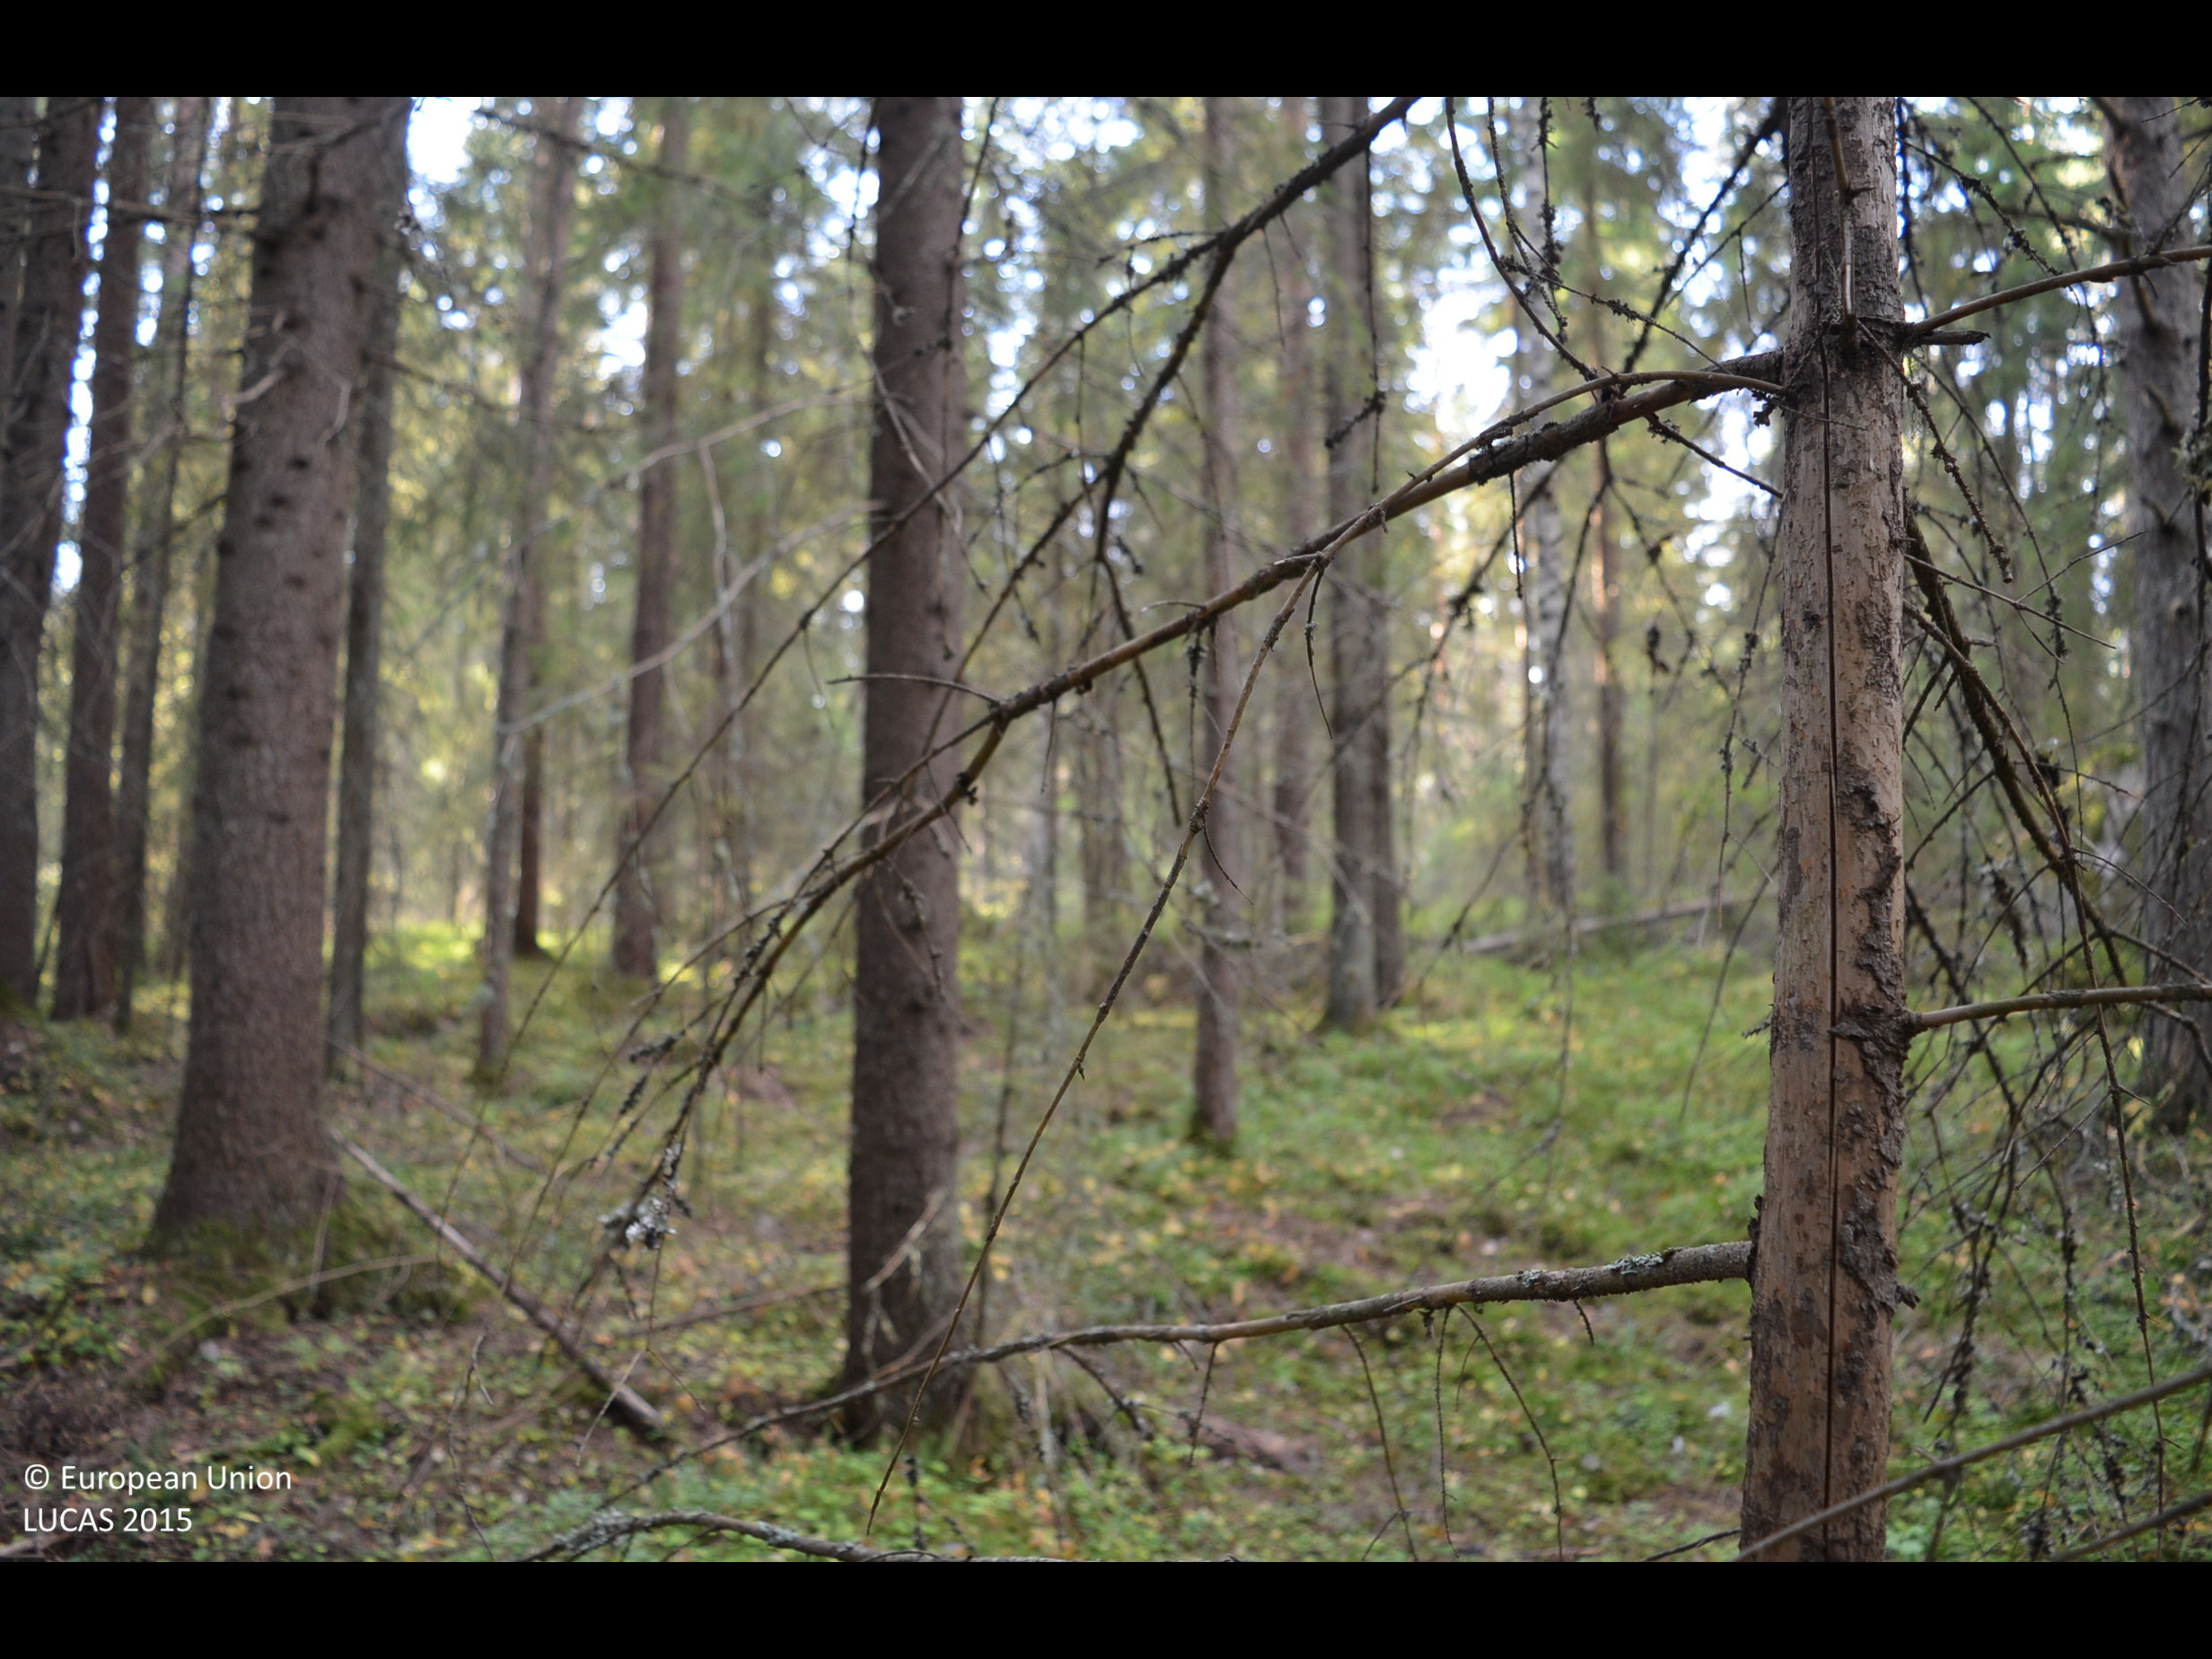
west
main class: Woodland
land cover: Other mixed woodland
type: boreal forest
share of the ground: > 75 %
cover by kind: coniferous forest trees 50 %, broadleaved forest trees 30 %, herbaceous plants 15 %, shrubs 5 %
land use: Forestry
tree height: > 5 m
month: September
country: FI
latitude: 63.0510
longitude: 23.8577
